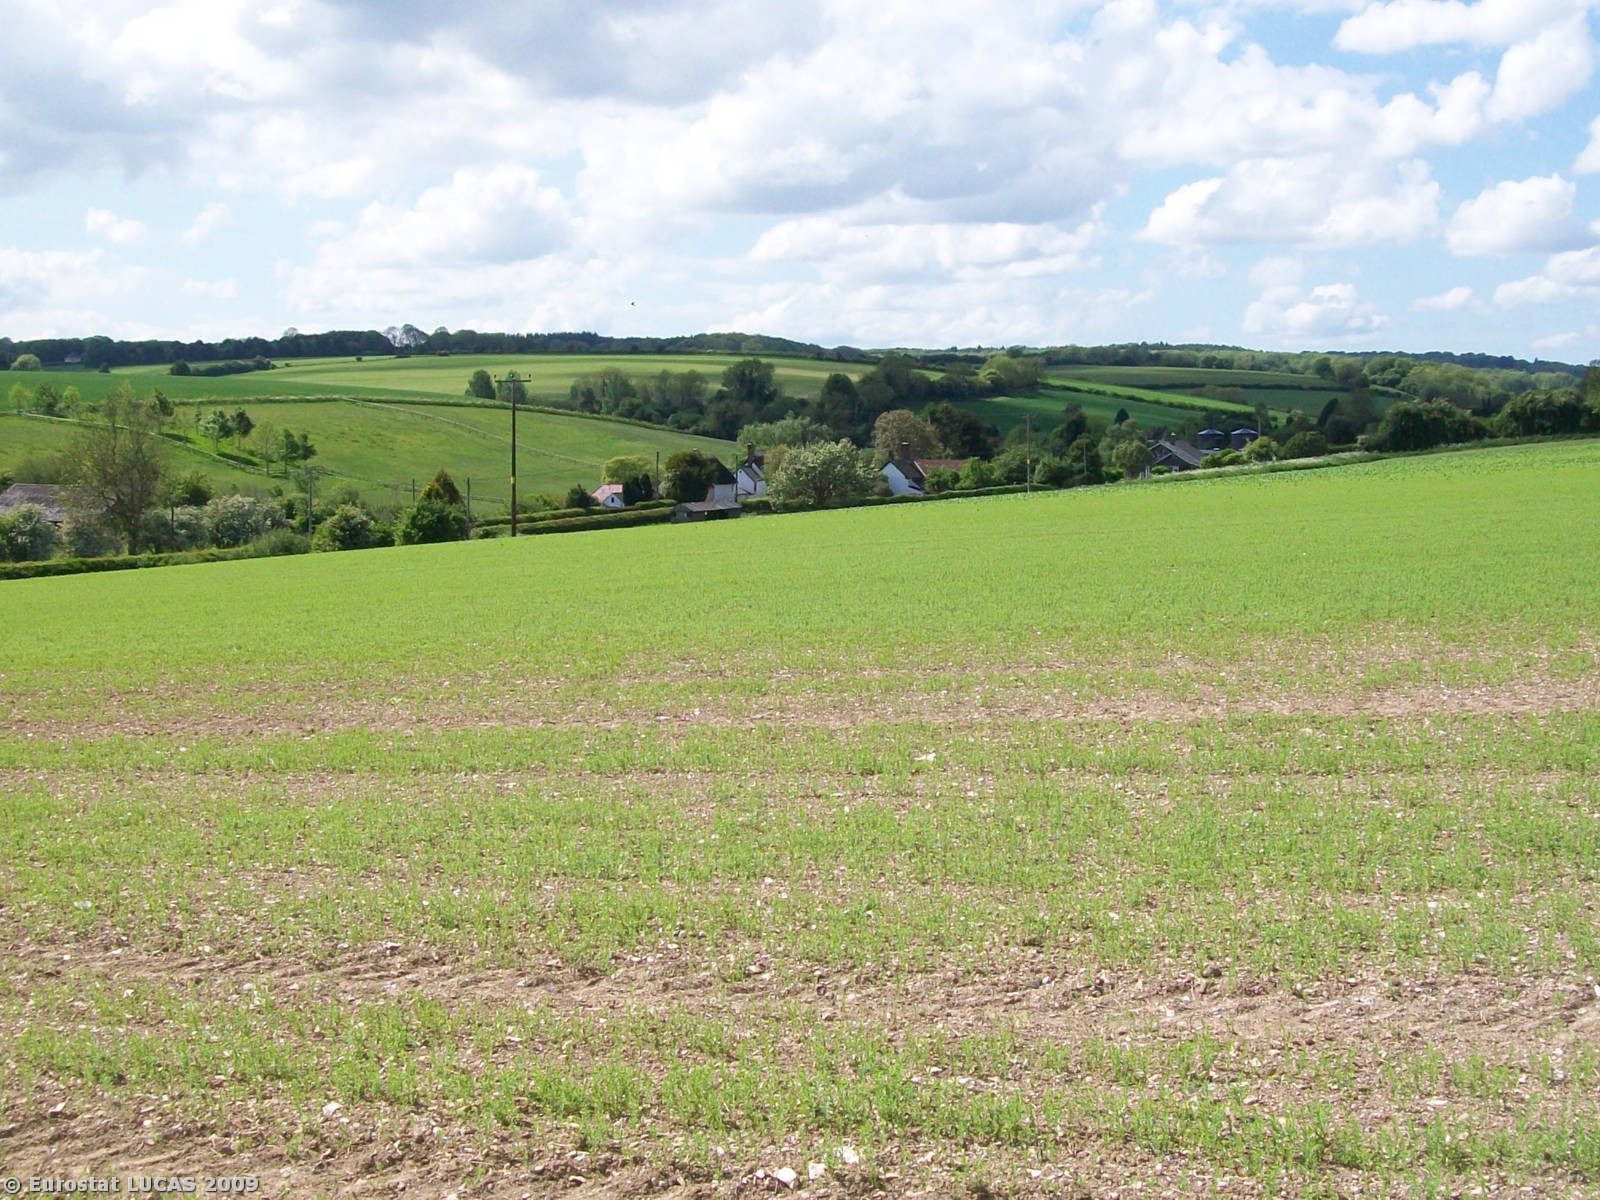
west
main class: Cropland
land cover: Other fibre and oleaginous crops
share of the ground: 50 - 75 %
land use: Agriculture (excluding fallow land and kitchen gardens)
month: May
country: GB
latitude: 50.9183
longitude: -2.1082
